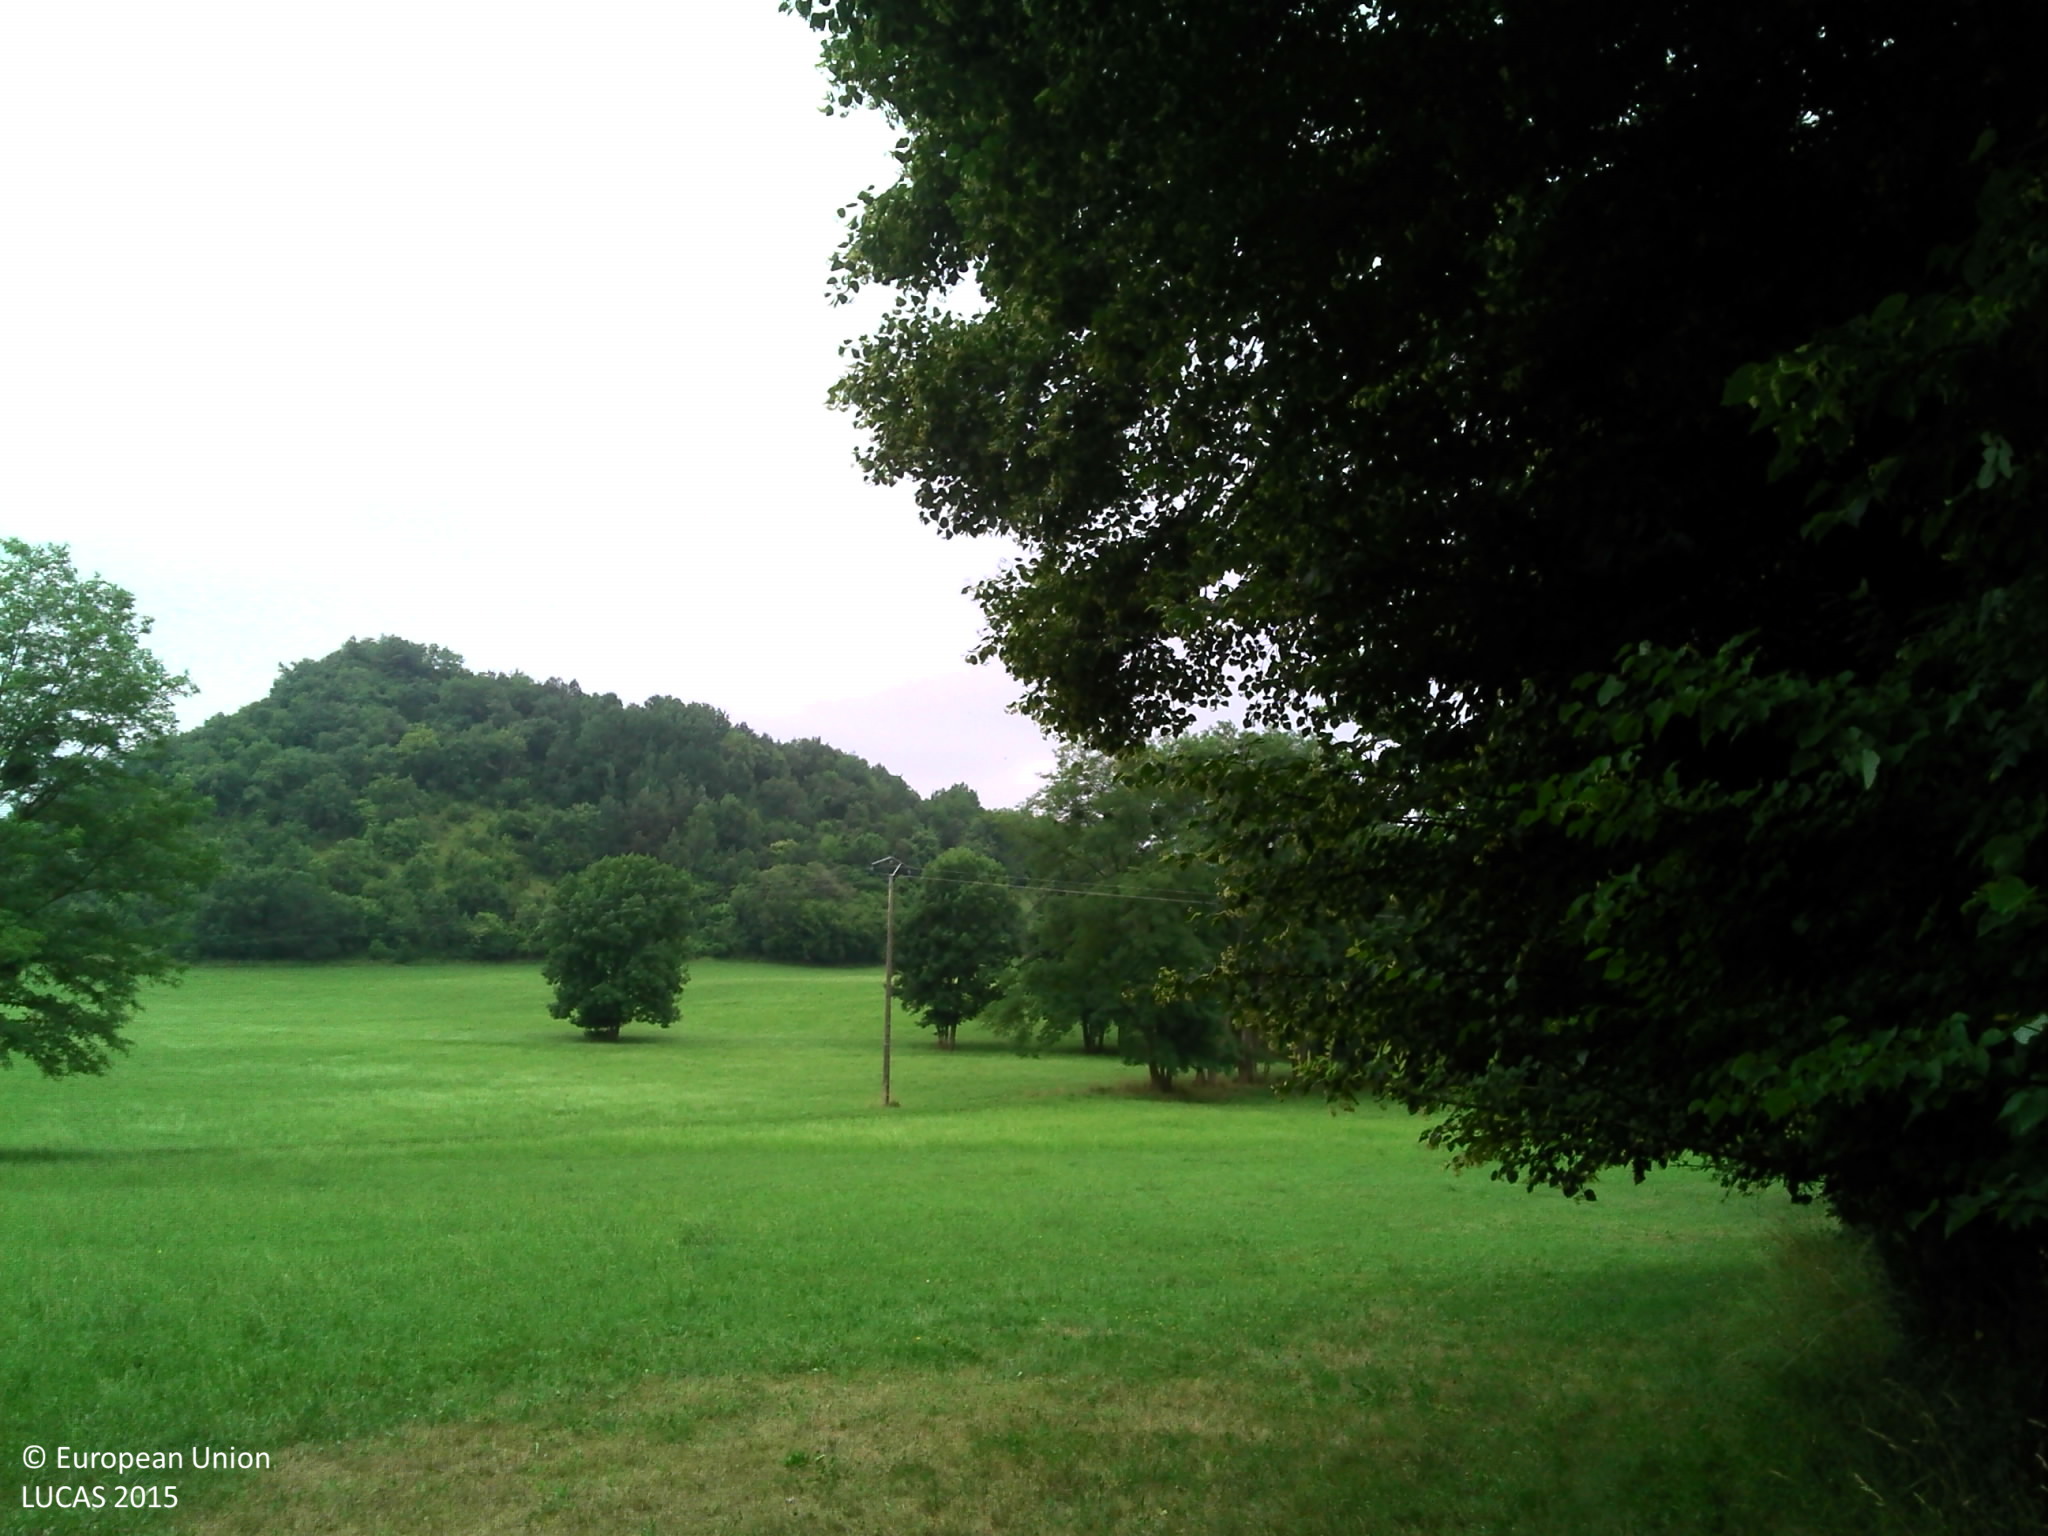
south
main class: Cropland
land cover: Temporary grasslands
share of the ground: > 75 %
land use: Agriculture (excluding fallow land and kitchen gardens)
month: July
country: FR
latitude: 43.0340
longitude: 1.4266
